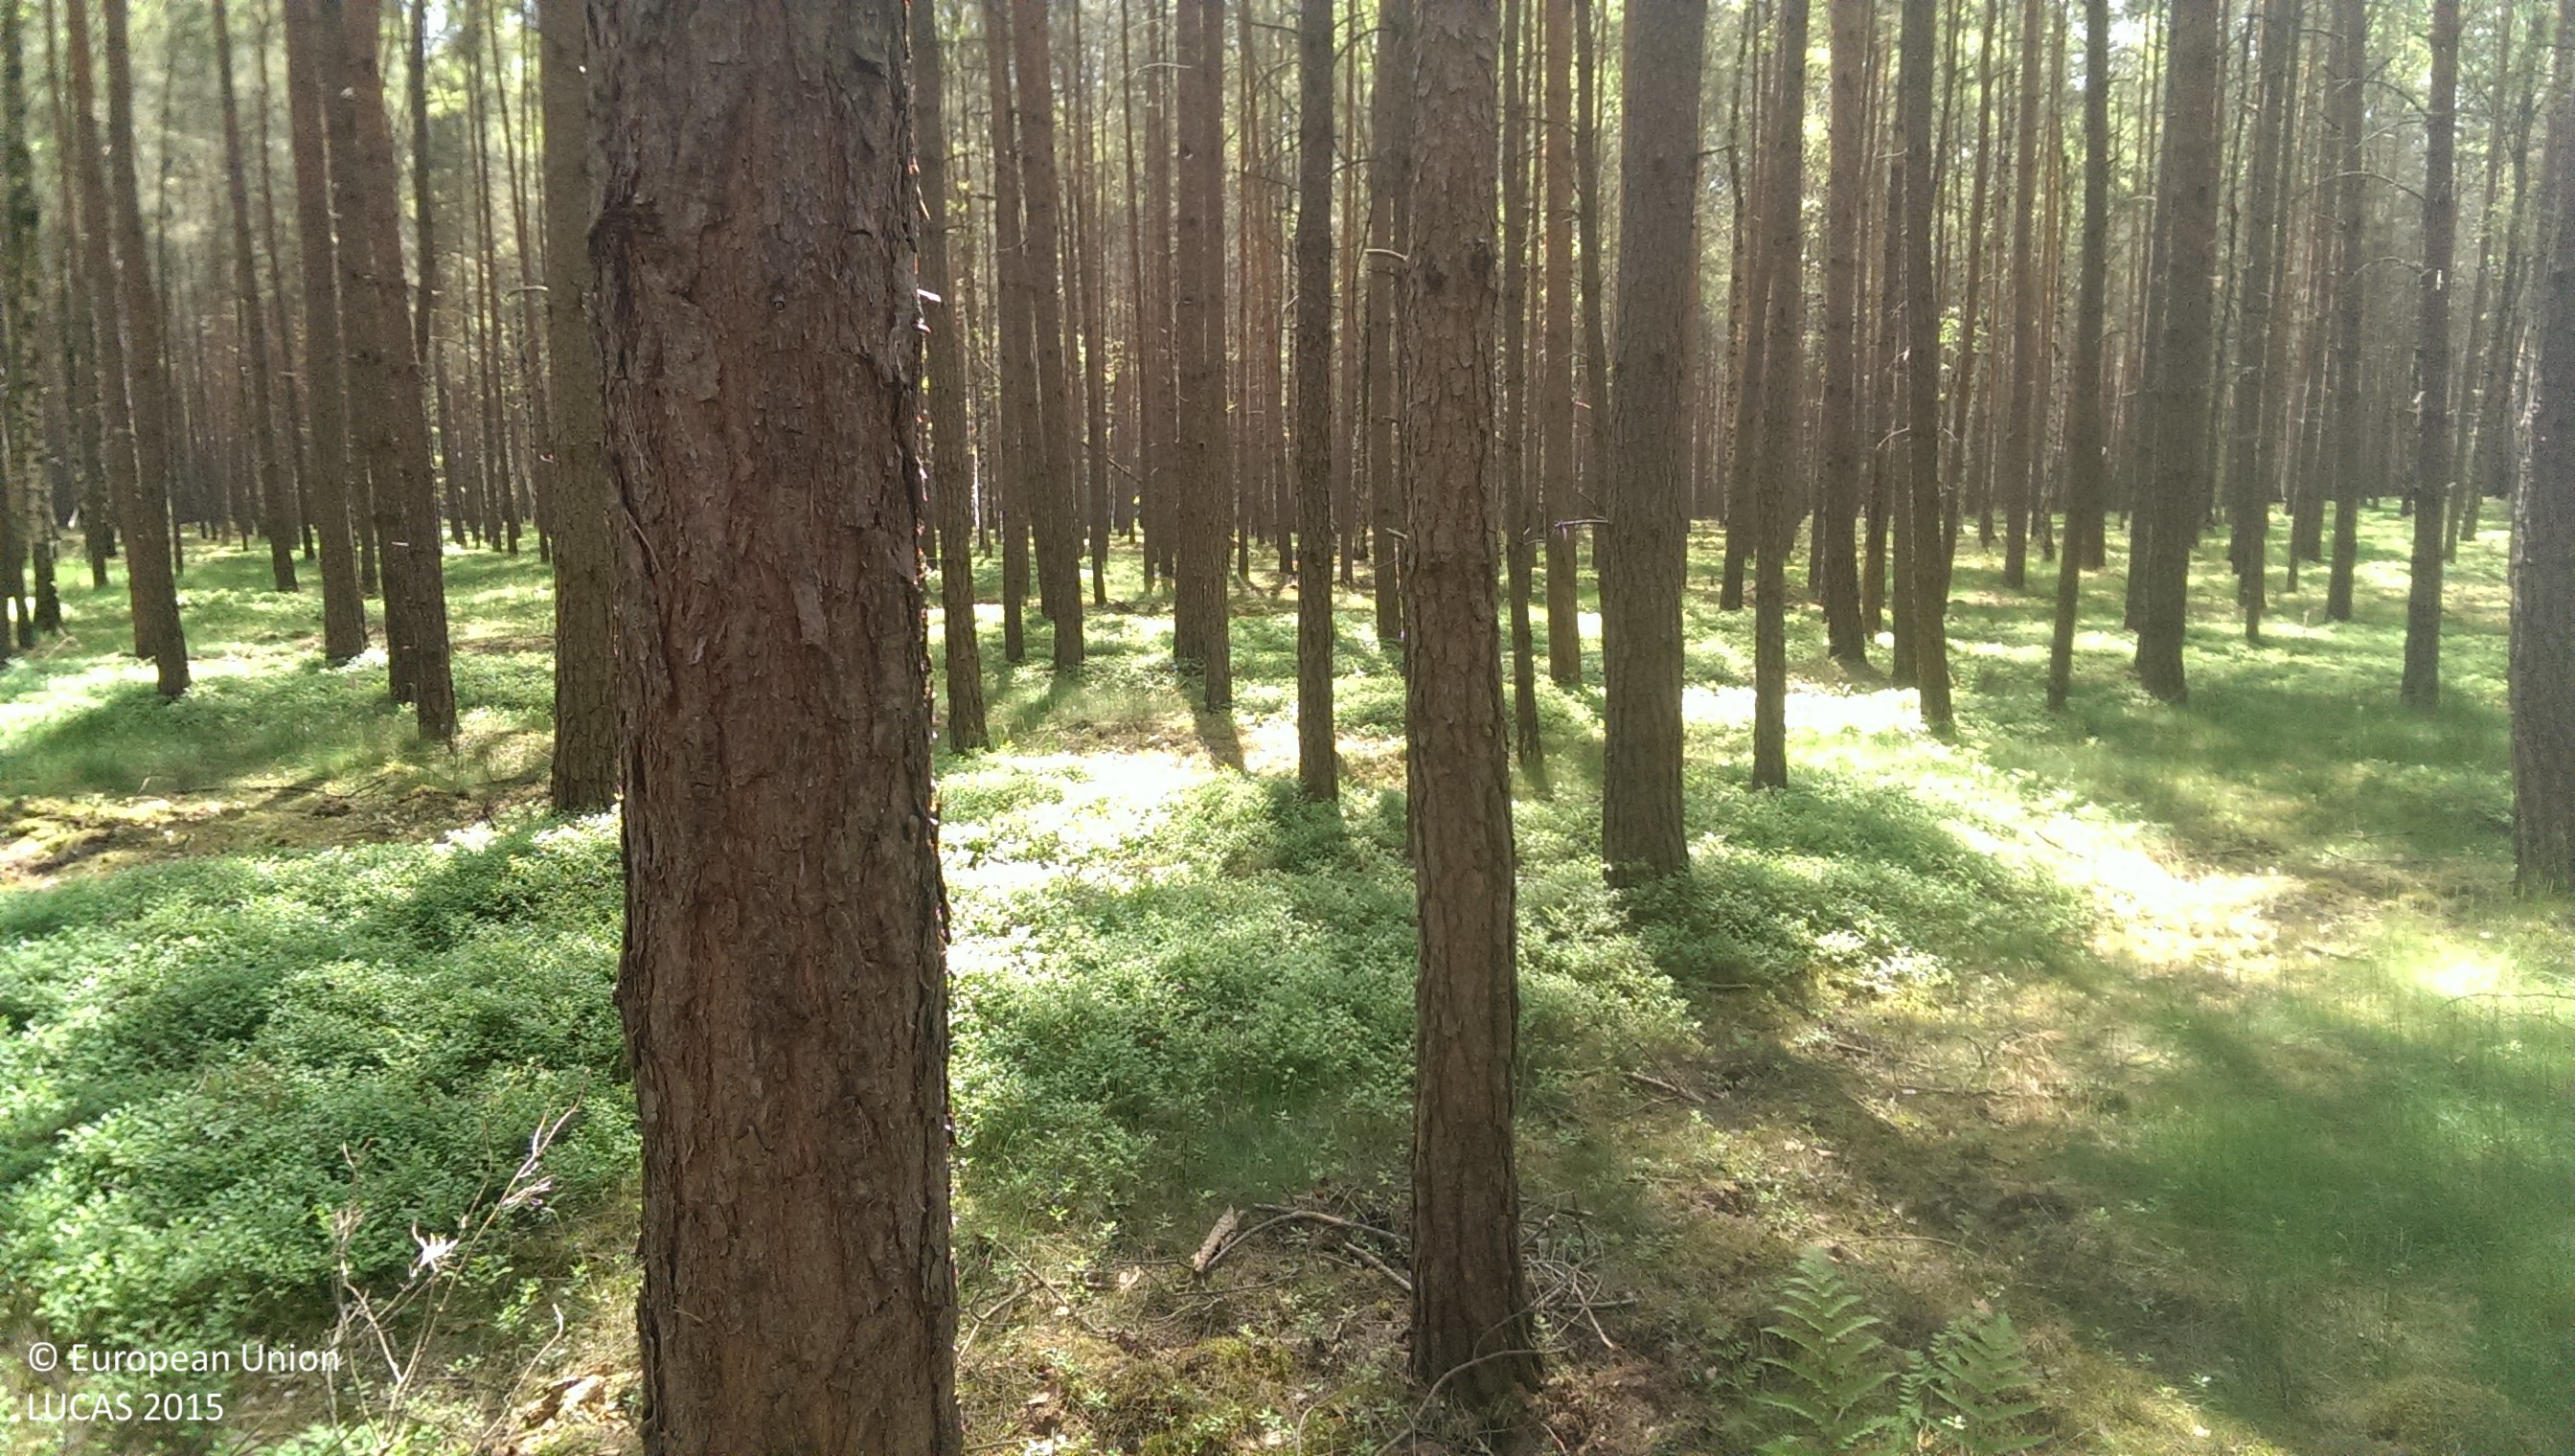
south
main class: Woodland
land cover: Pine dominated coniferous woodland
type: hemiboreal forest and nemoral coniferous forest and mixed broadleaved-coniferous forest
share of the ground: 50 - 75 %
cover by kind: coniferous forest trees 65 %, herbaceous plants 15 %, lichens and mosses 15 %, broadleaved forest trees 5 %
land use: Forestry
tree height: > 5 m
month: May
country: PL
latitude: 52.2483
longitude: 16.2609
